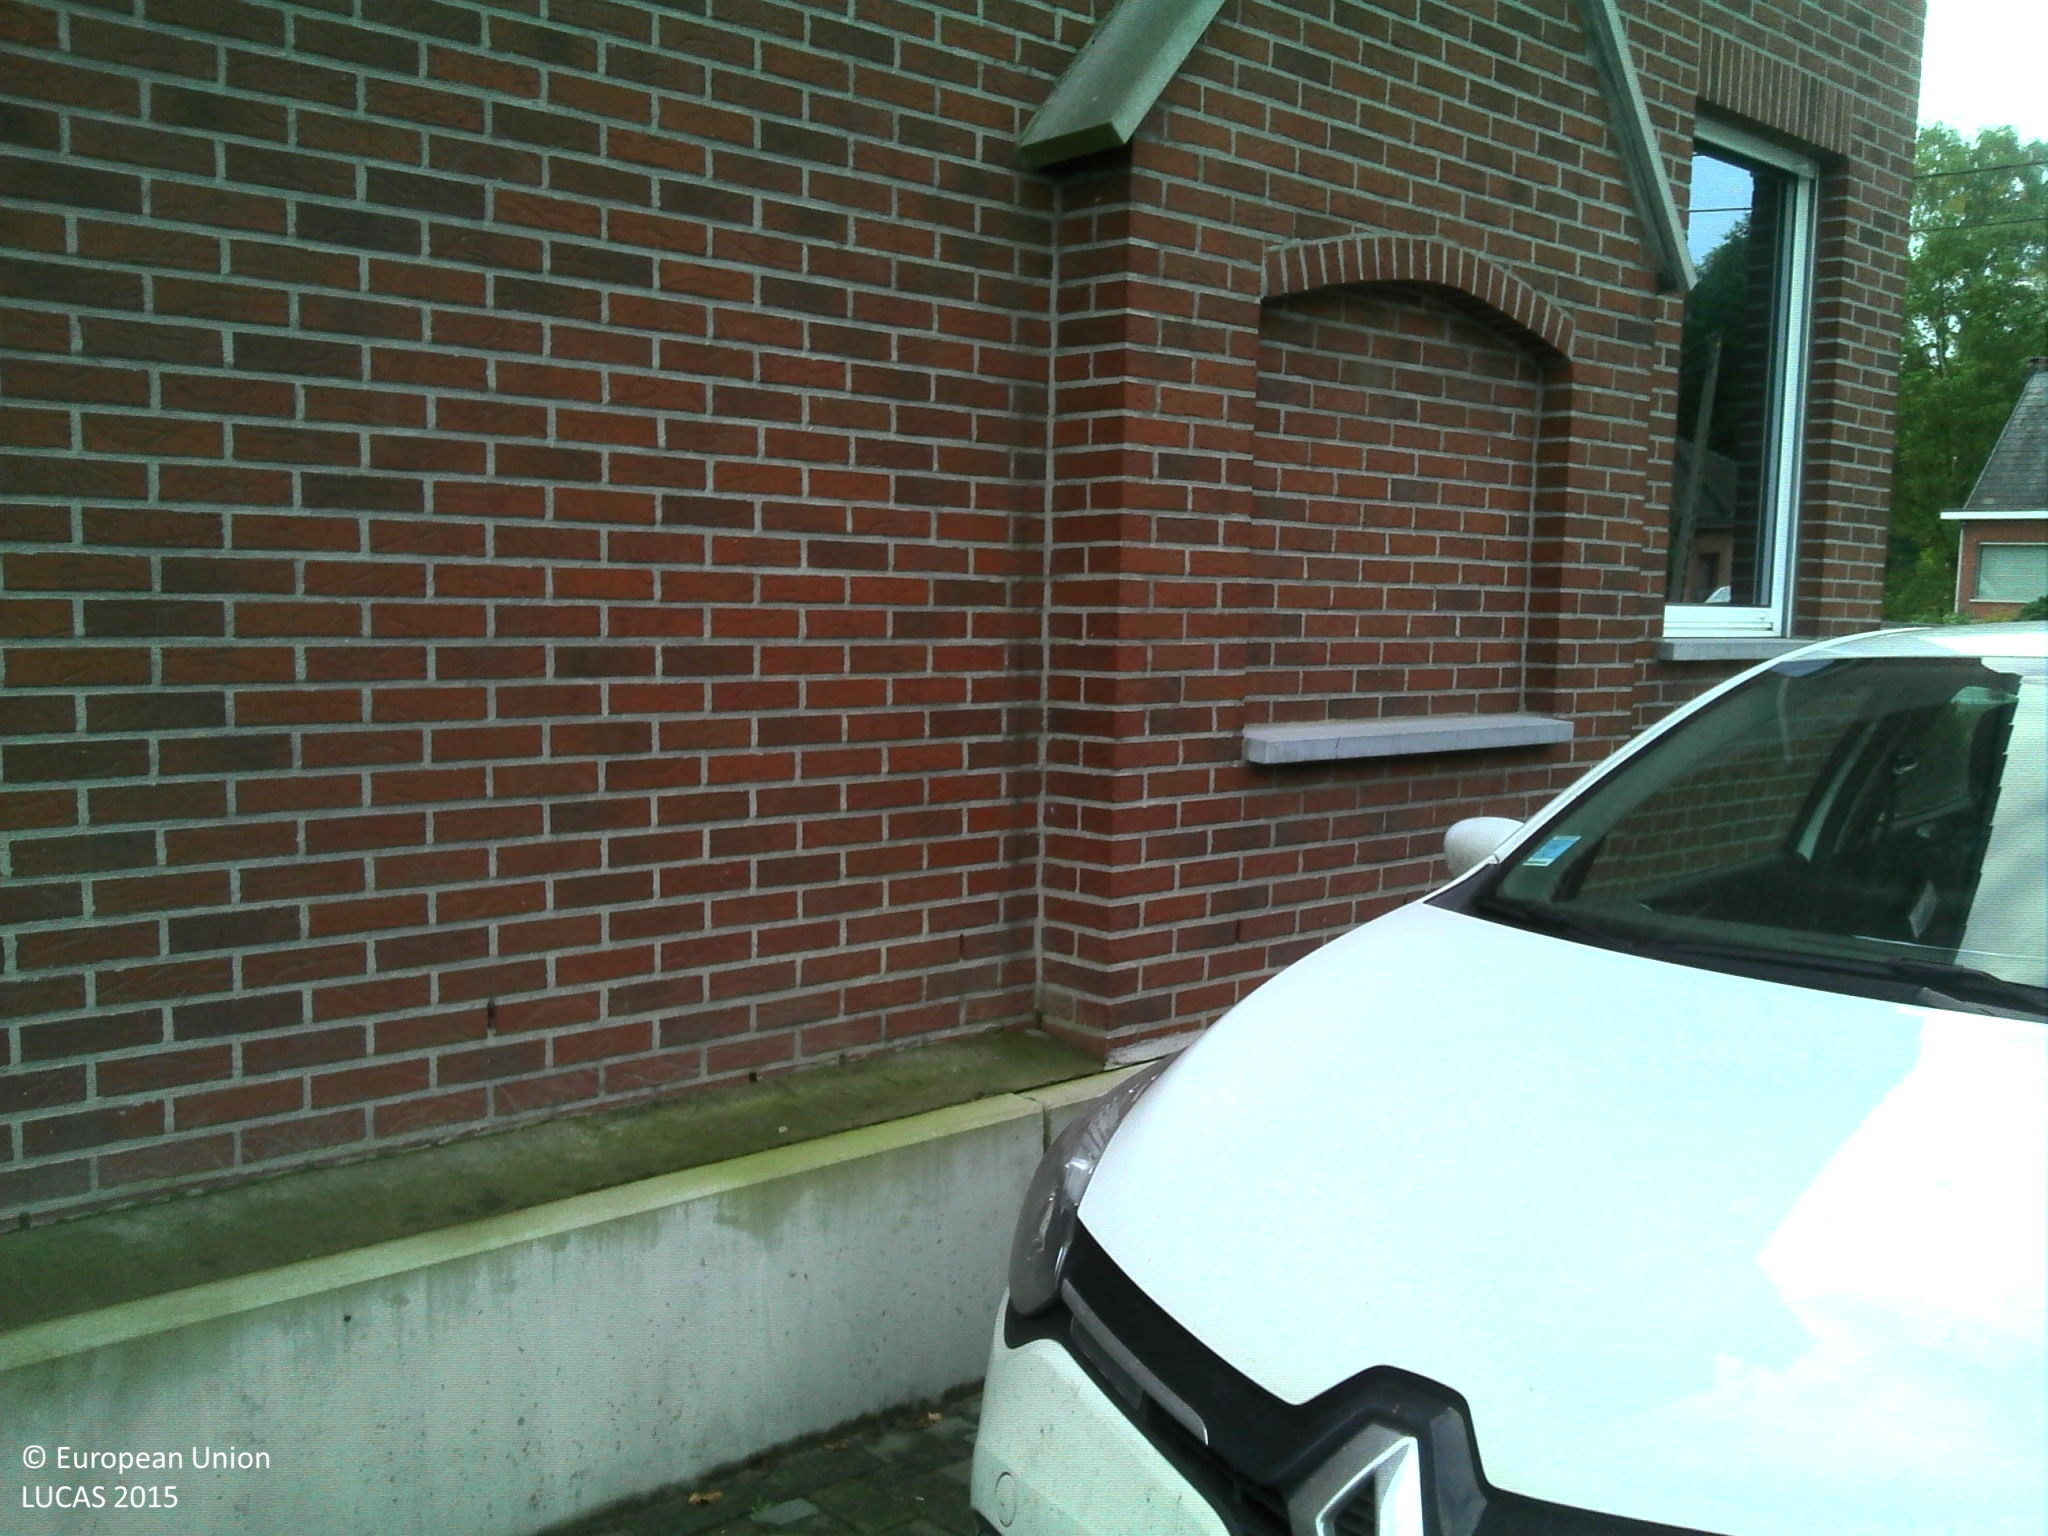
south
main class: Grassland
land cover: Grassland without tree/shrub cover
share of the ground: > 75 %
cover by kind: herbaceous plants 95 %, shrubs 5 %
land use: Residential
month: October
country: BE
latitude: 50.9906
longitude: 4.5393
